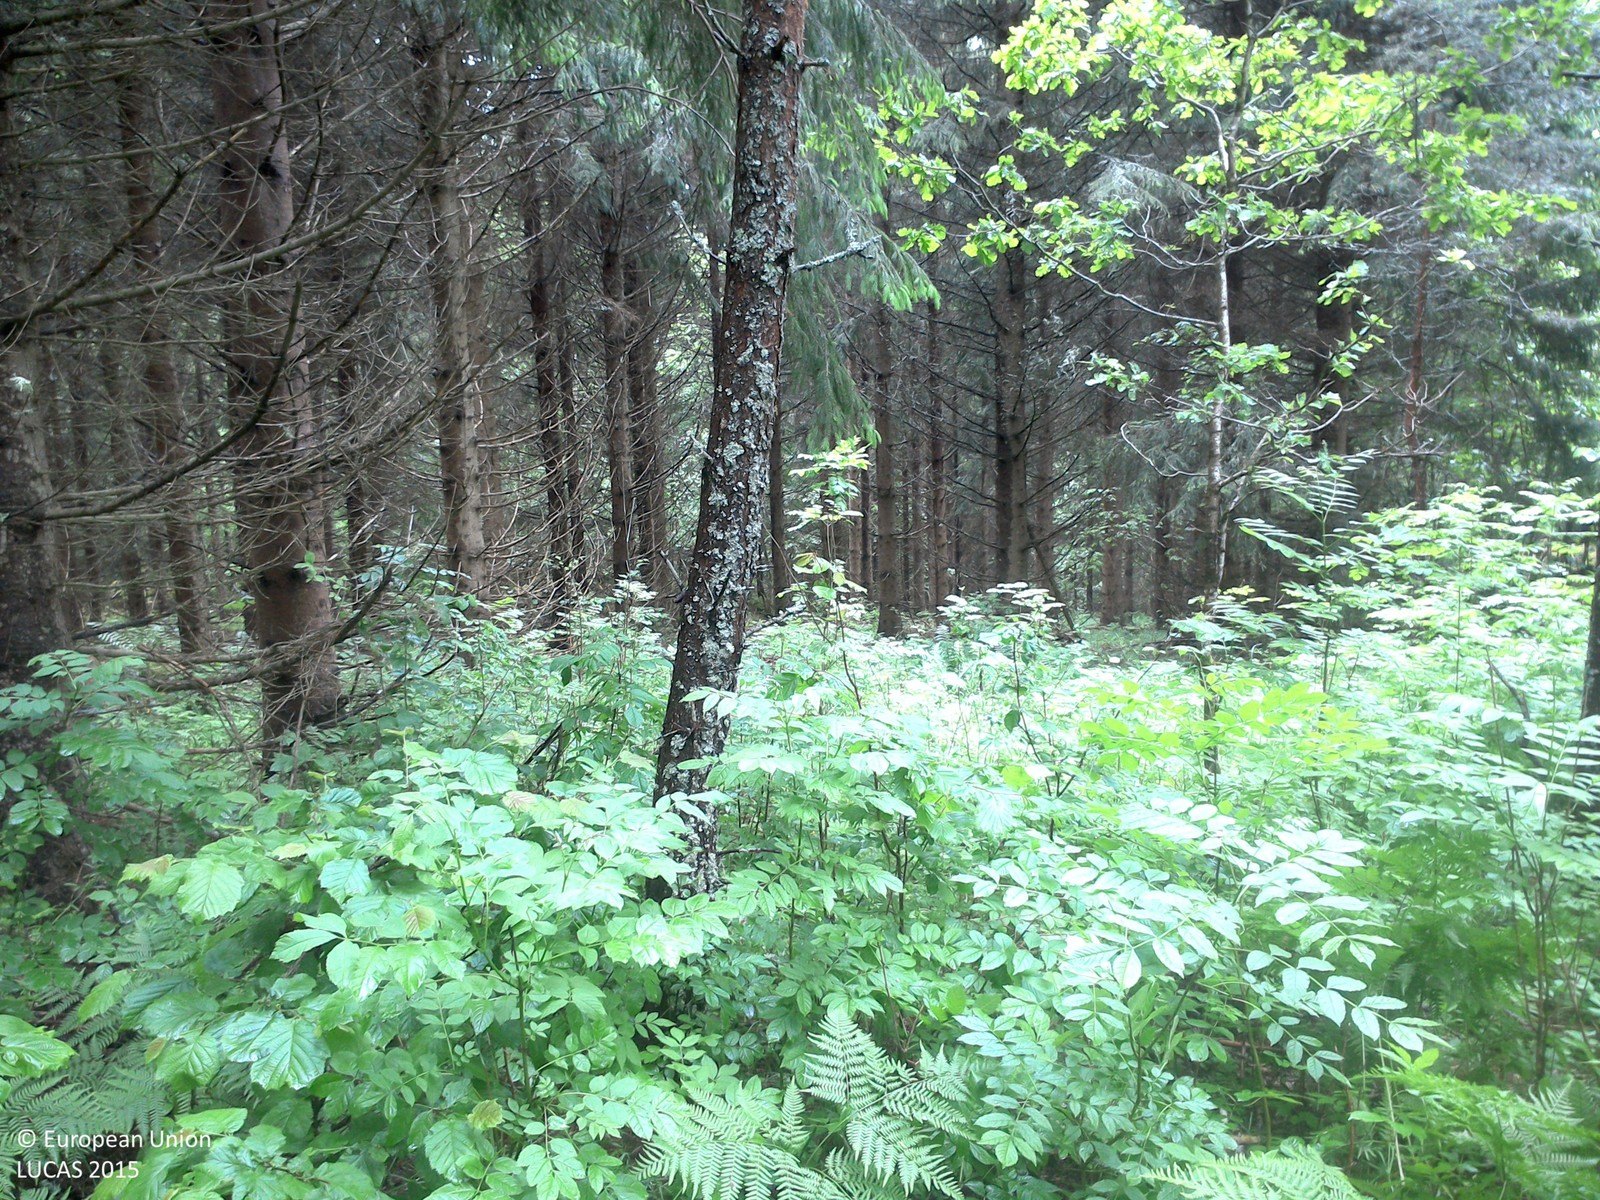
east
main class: Woodland
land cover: Broadleaved woodland
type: boreal forest
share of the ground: > 75 %
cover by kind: broadleaved forest trees 75 %, herbaceous plants 25 %
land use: Forestry
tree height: > 5 m
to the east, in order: Broadleaved woodland; Spruce dominated coniferous woodland; Spruce dominated mixed woodland; Spruce dominated coniferous woodland
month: June
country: SE
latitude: 58.0665
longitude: 15.6062
